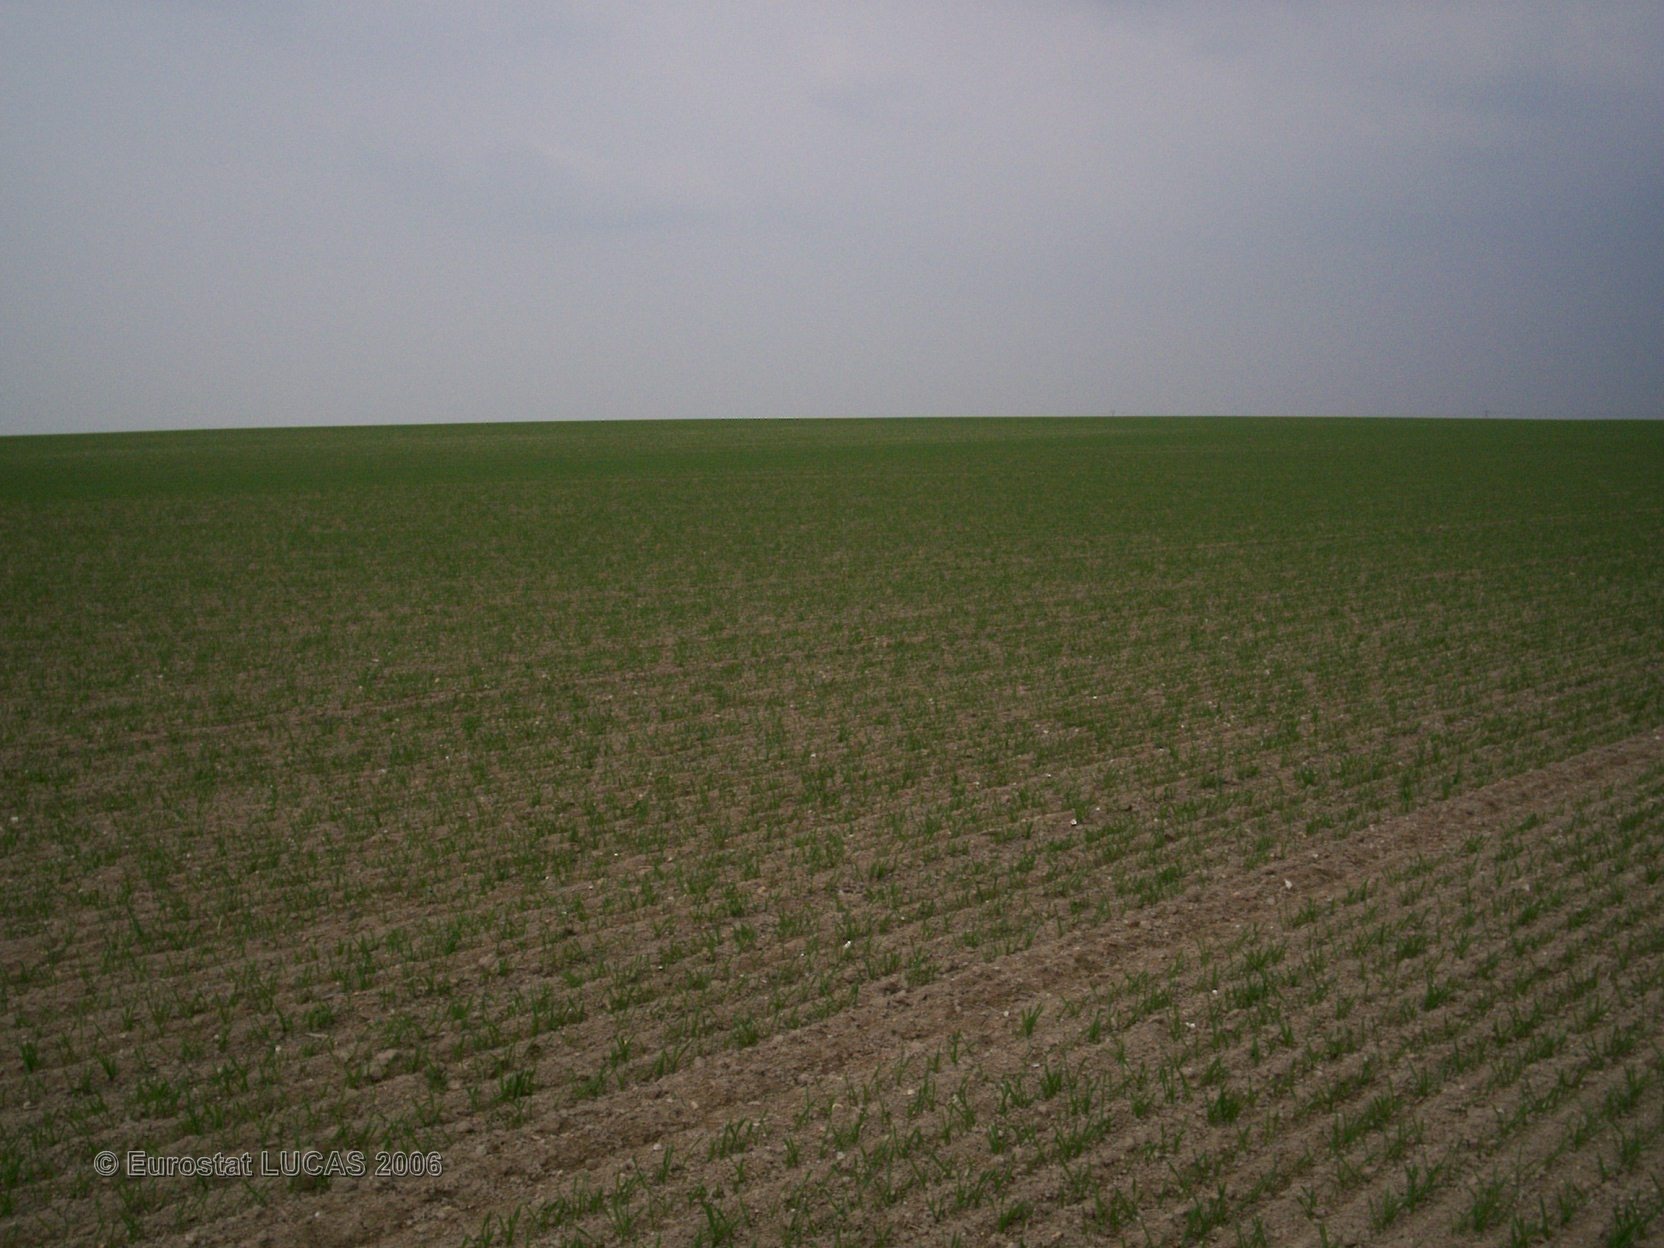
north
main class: Cropland
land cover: Barley
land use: Agriculture (excluding fallow land and kitchen gardens)
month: April
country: FR
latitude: 48.2408
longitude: 4.0042
